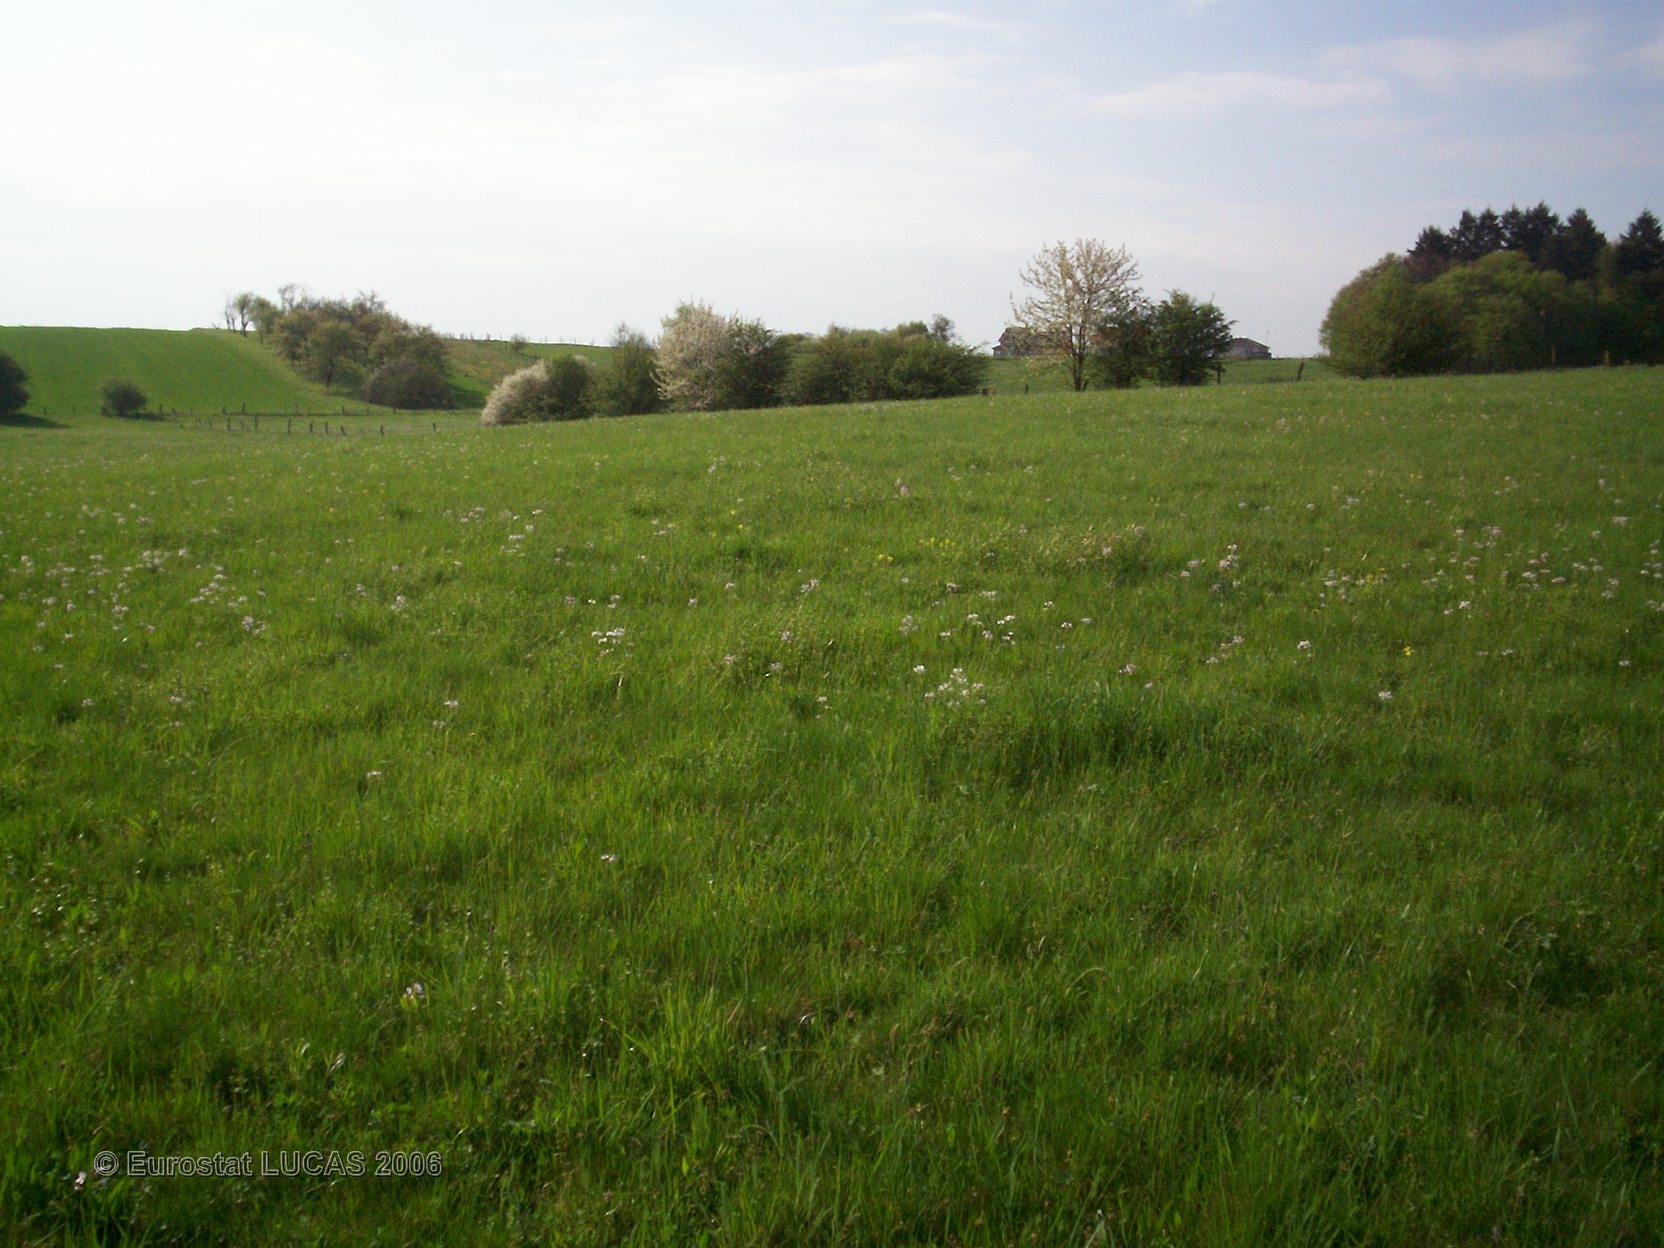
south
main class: Grassland
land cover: Grassland without tree/shrub cover
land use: Agriculture (excluding fallow land and kitchen gardens)
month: April
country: FR
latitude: 49.0448
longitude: 6.9221
